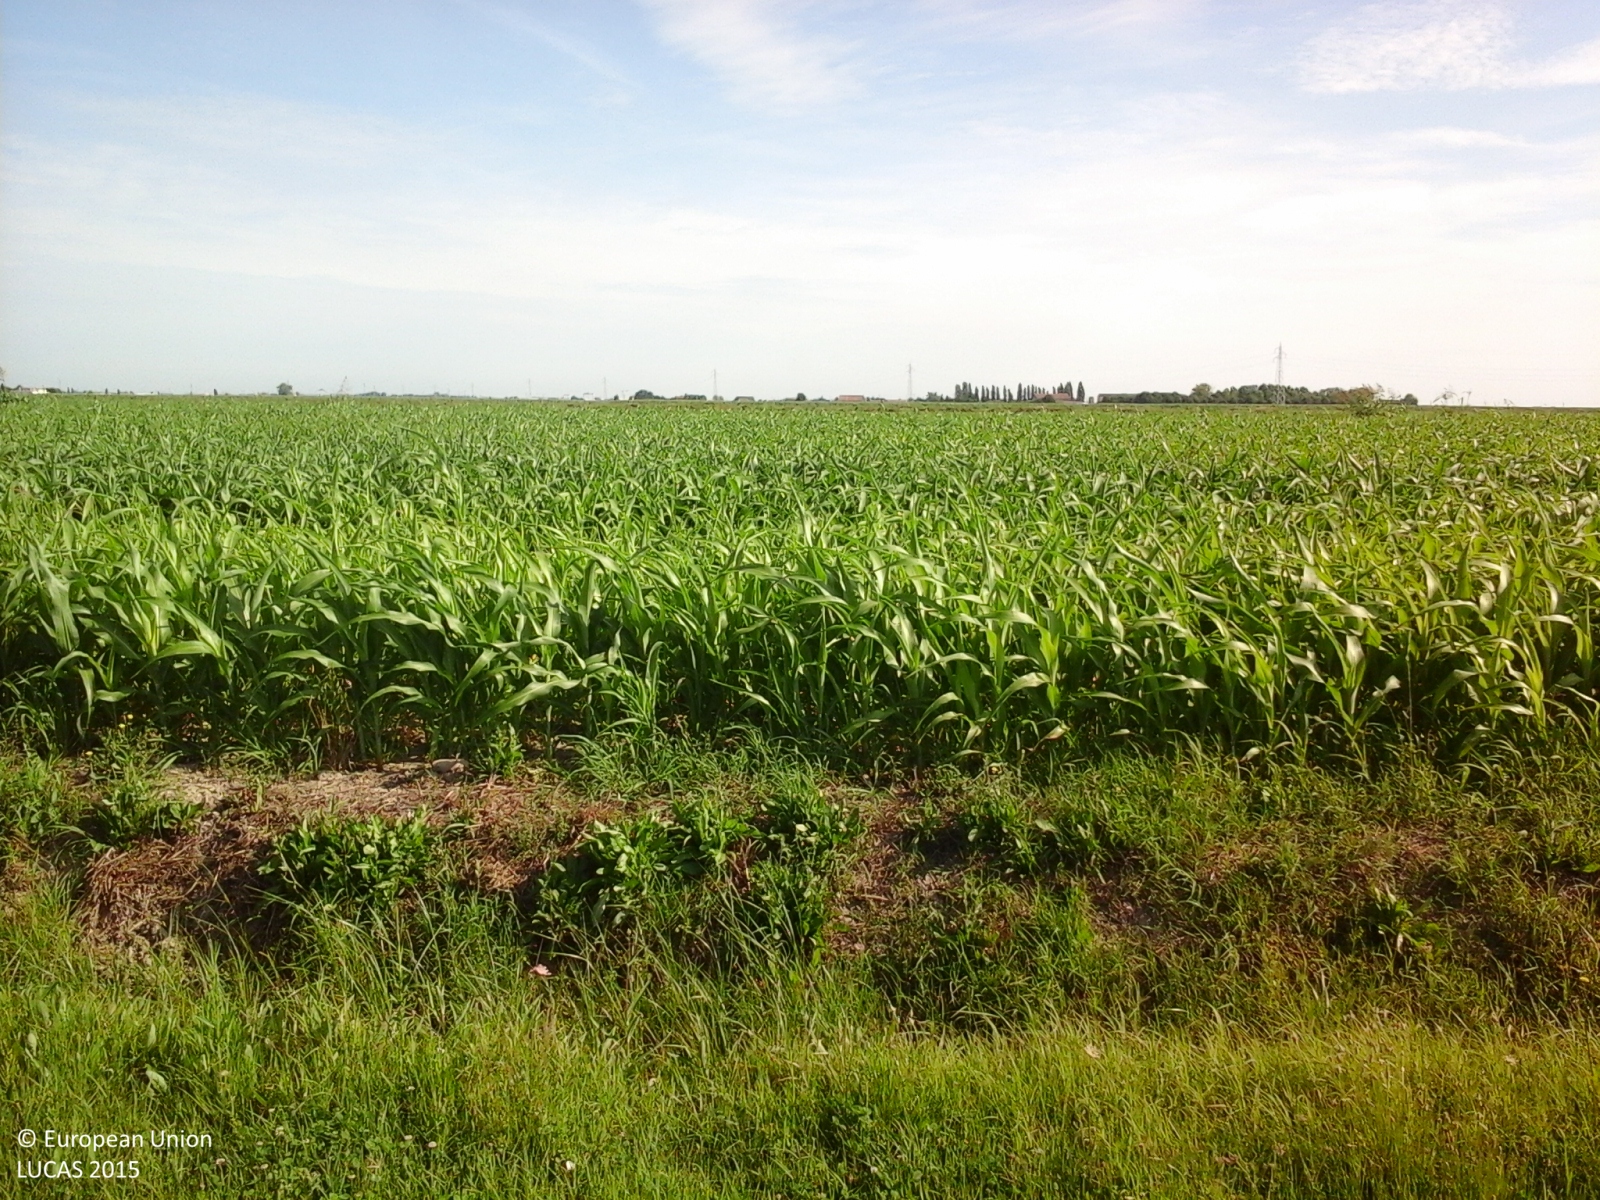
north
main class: Cropland
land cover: Soya
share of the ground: > 75 %
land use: Agriculture (excluding fallow land and kitchen gardens)
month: June
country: IT
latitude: 44.9933
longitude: 12.2664
